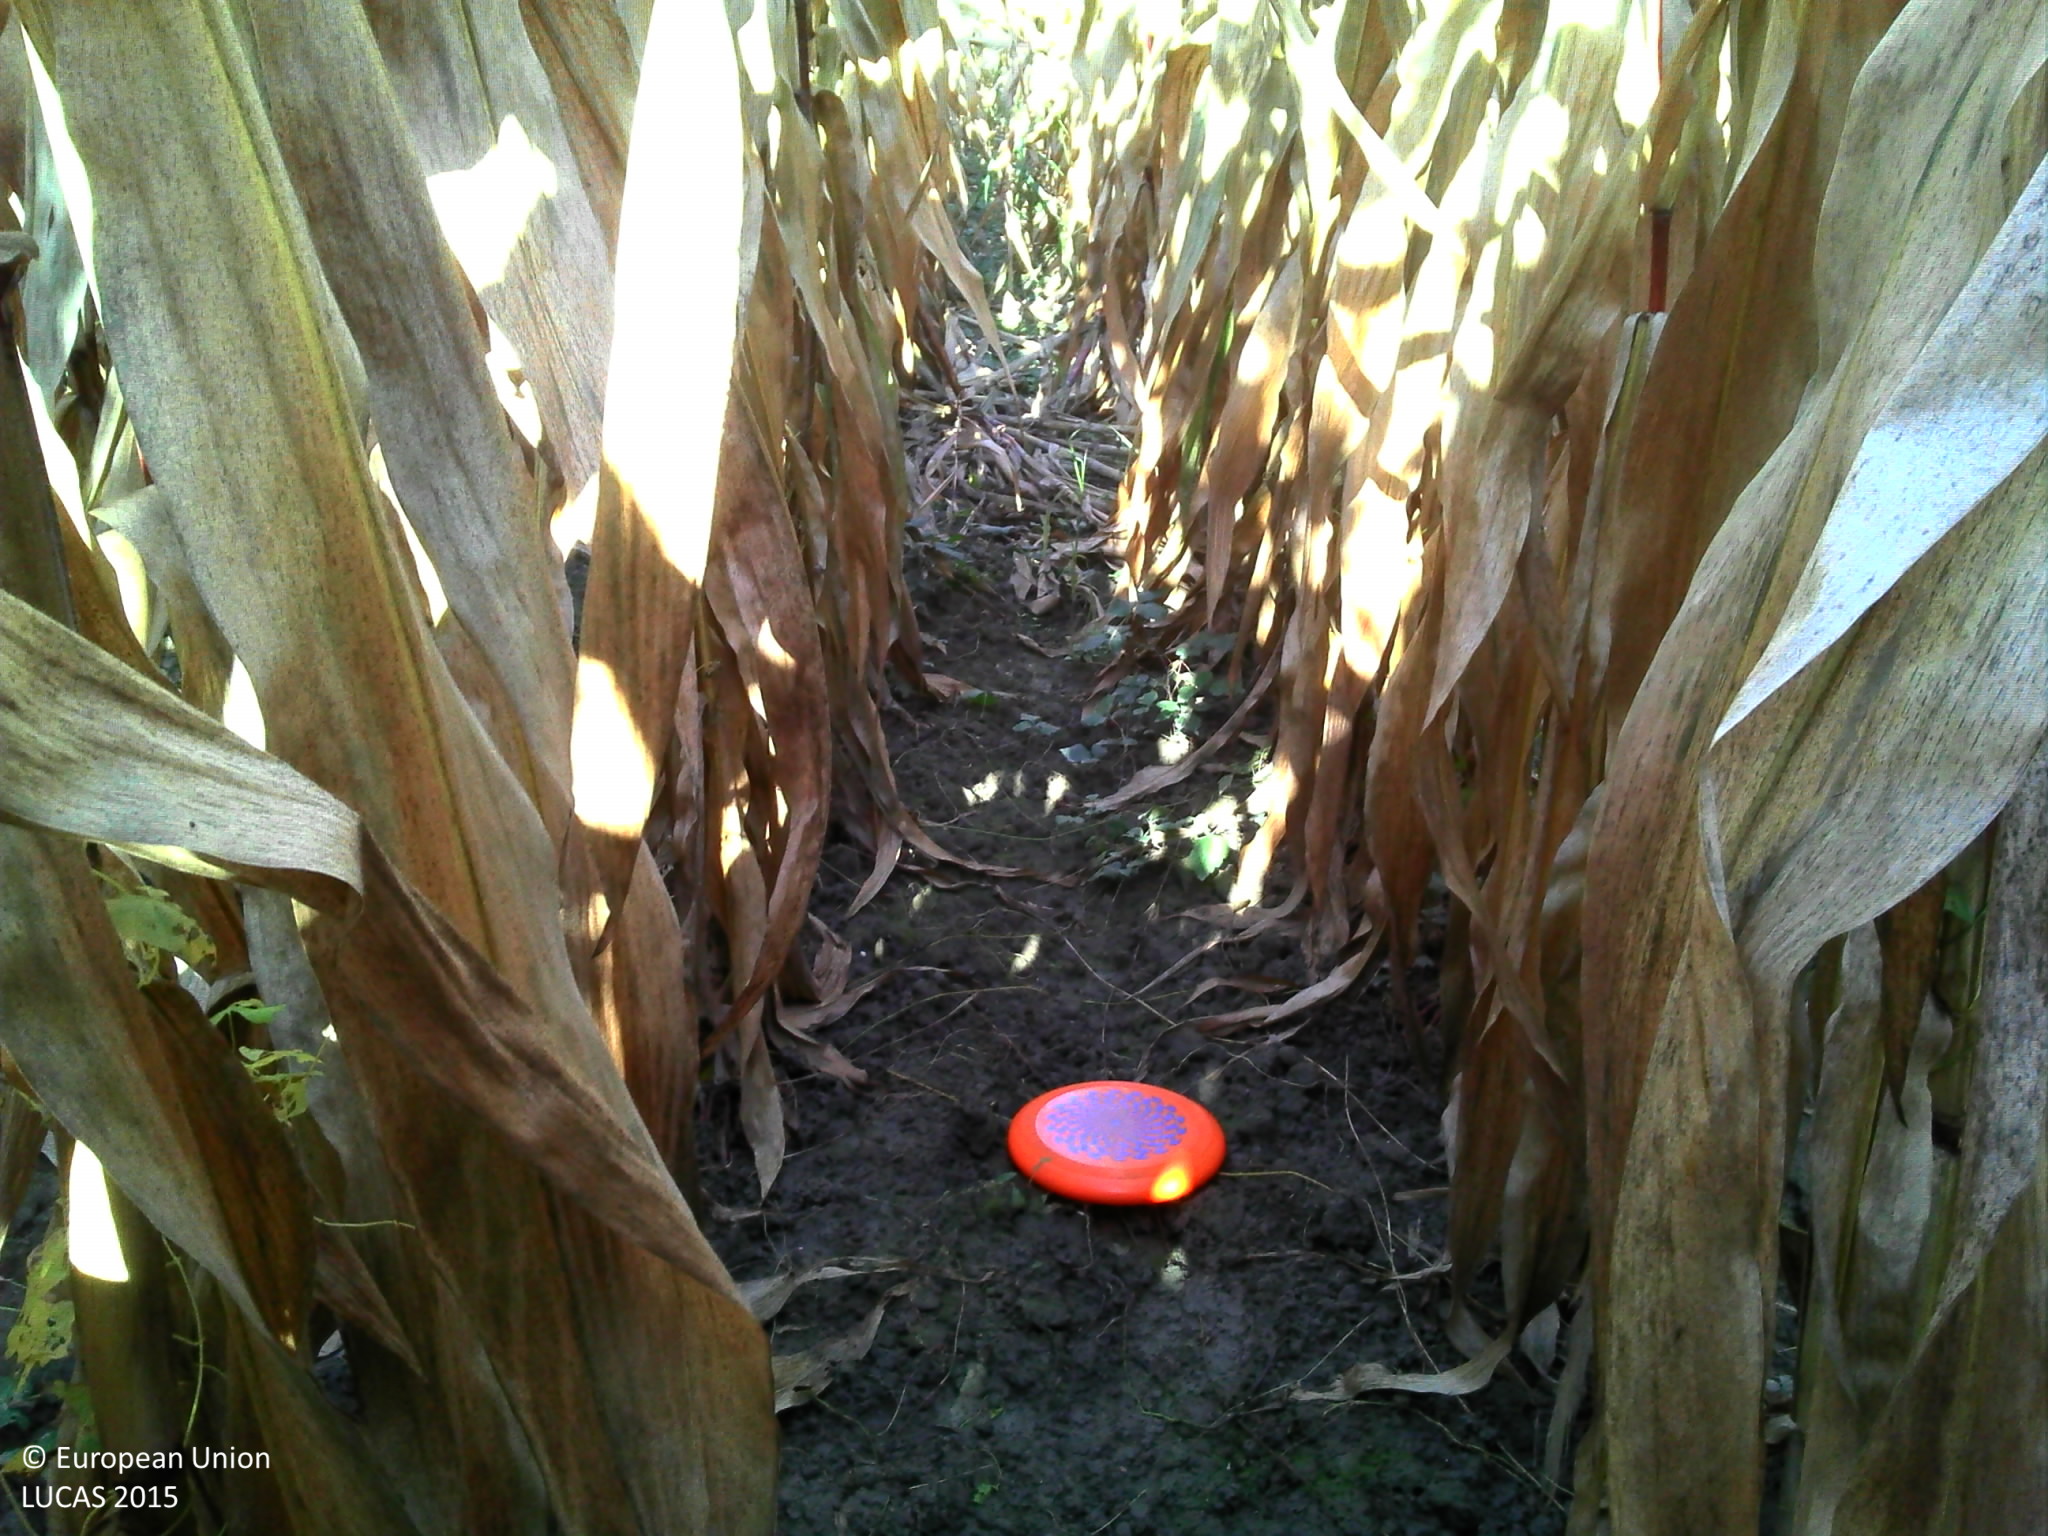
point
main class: Cropland
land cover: Maize
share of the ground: > 75 %
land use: Agriculture (excluding fallow land and kitchen gardens)
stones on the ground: < 10 %
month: October
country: FR
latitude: 45.6388
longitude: 6.3224
